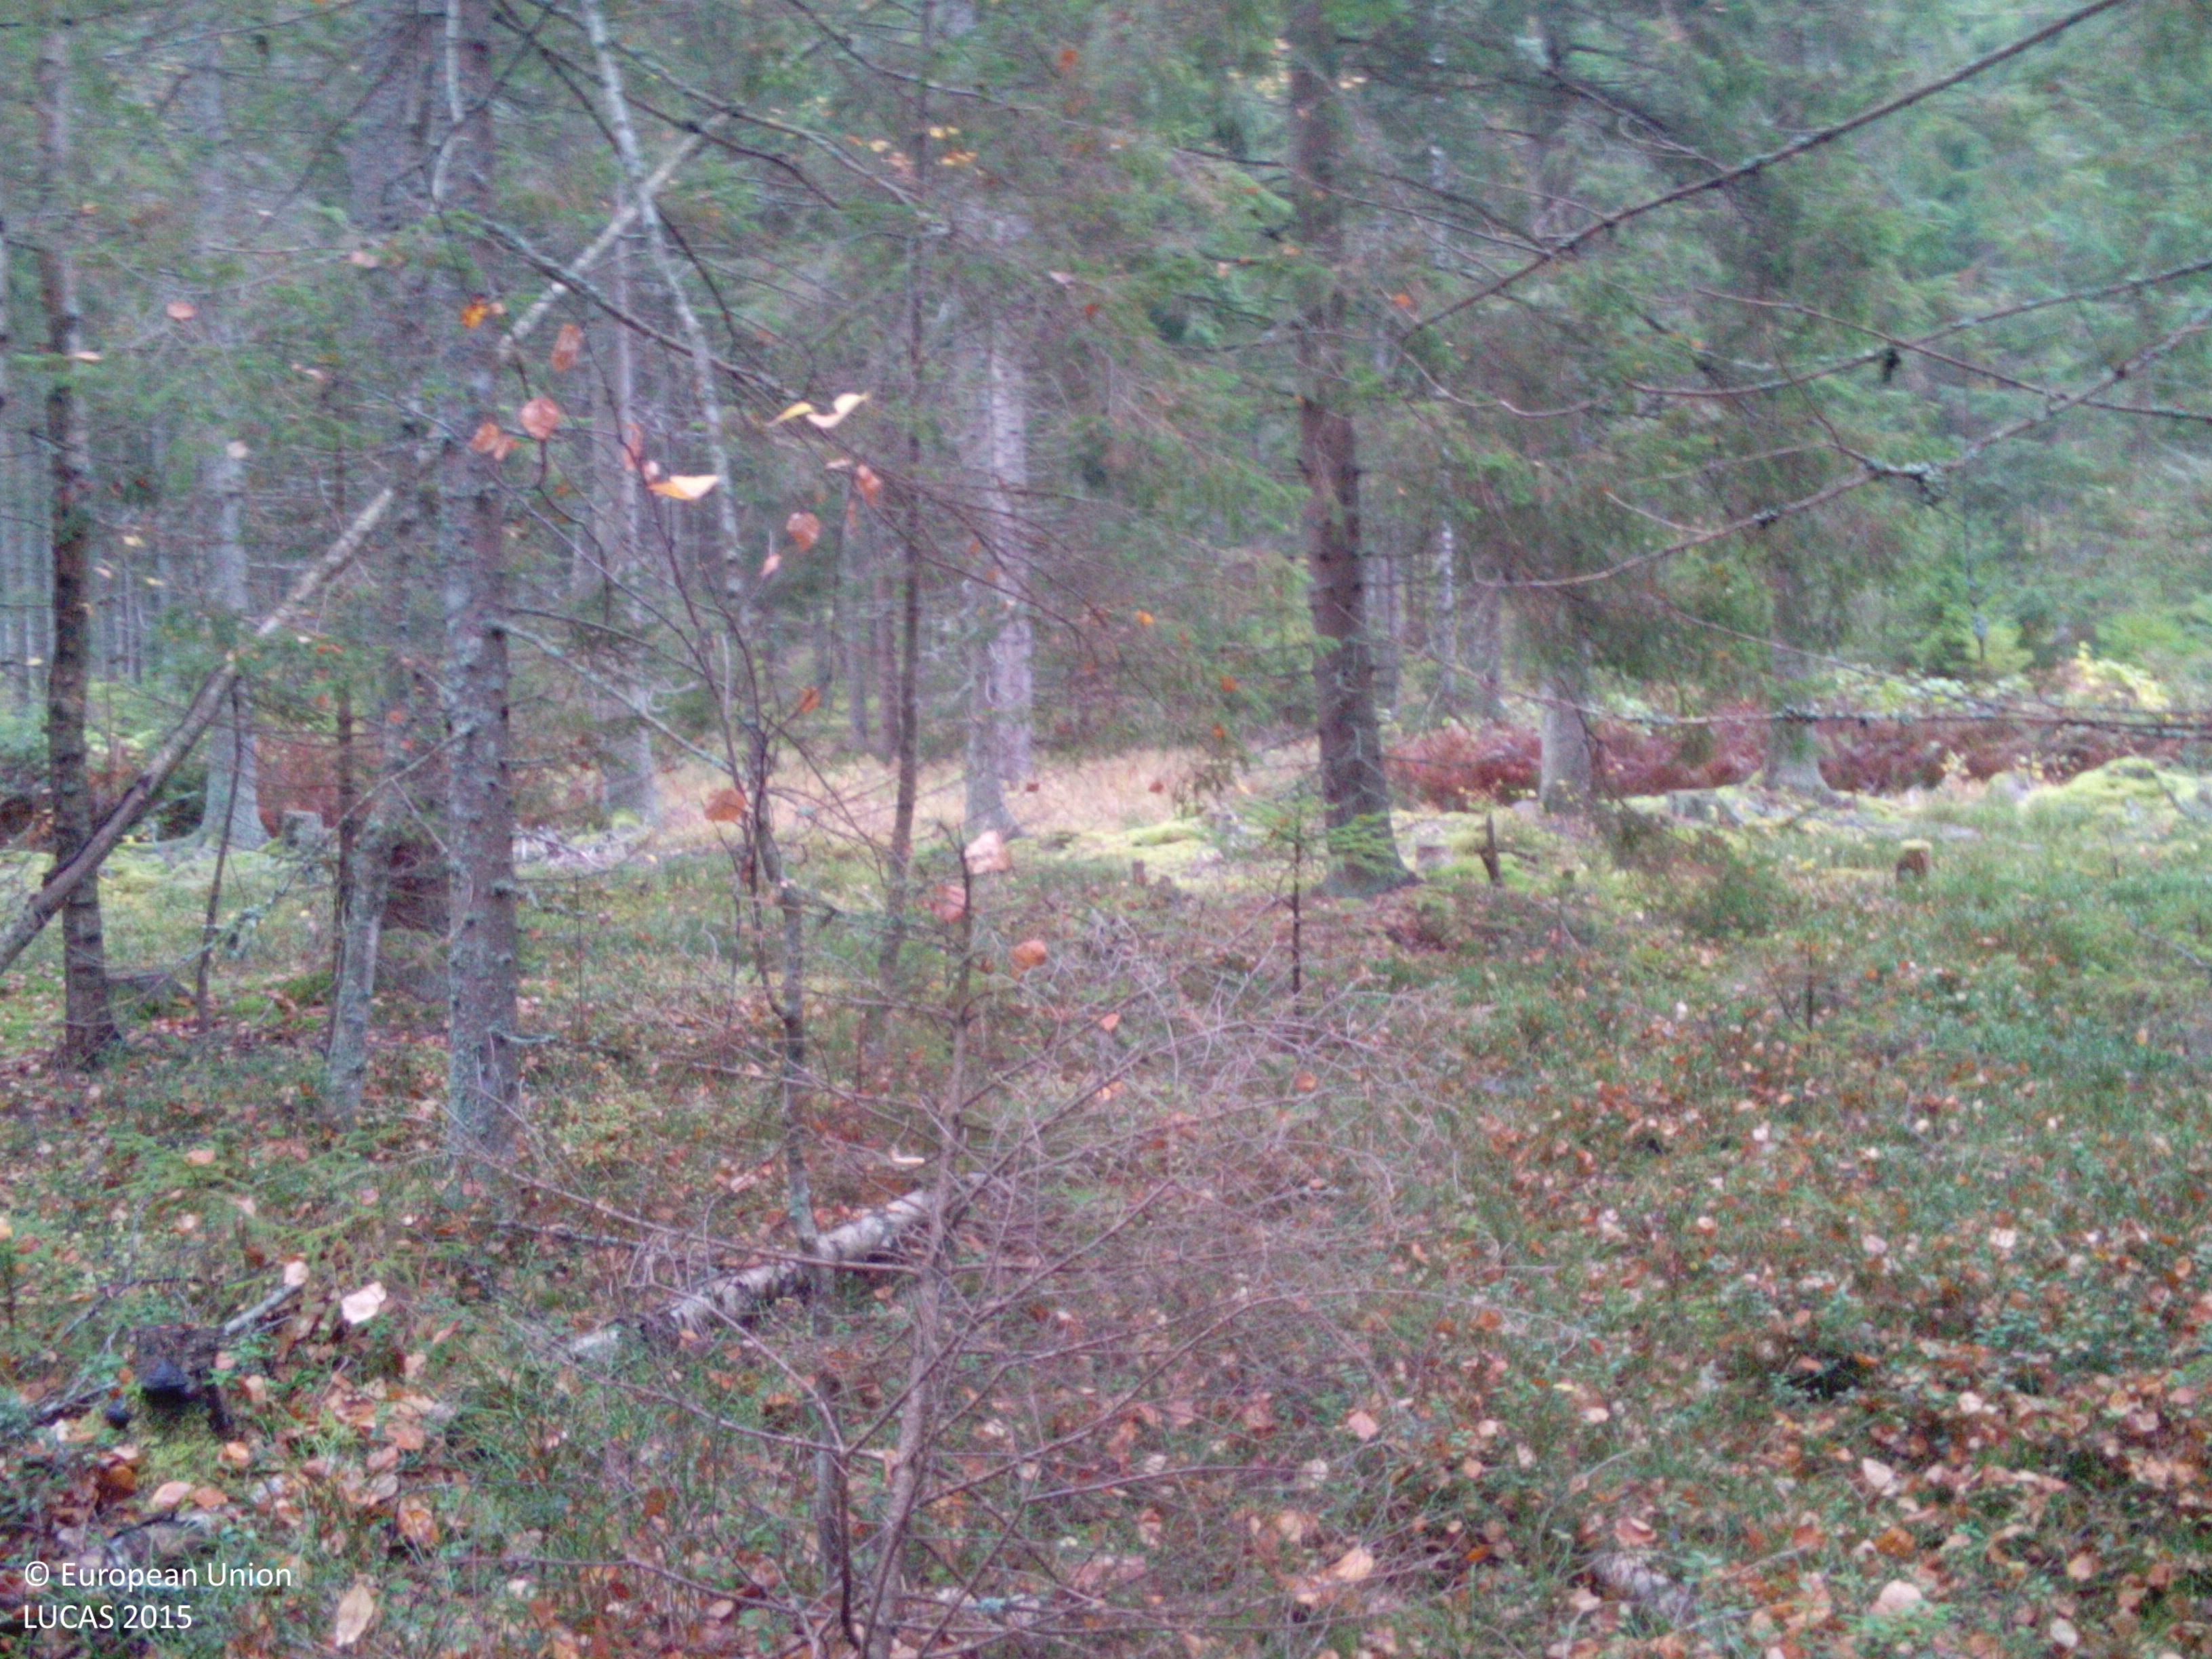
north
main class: Woodland
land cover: Spruce dominated mixed woodland
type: boreal forest
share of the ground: > 75 %
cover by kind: coniferous forest trees 45 %, broadleaved forest trees 40 %, lichens and mosses 10 %, herbaceous plants 5 %
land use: Forestry
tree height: > 5 m
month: October
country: SE
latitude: 59.1057
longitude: 16.1920
